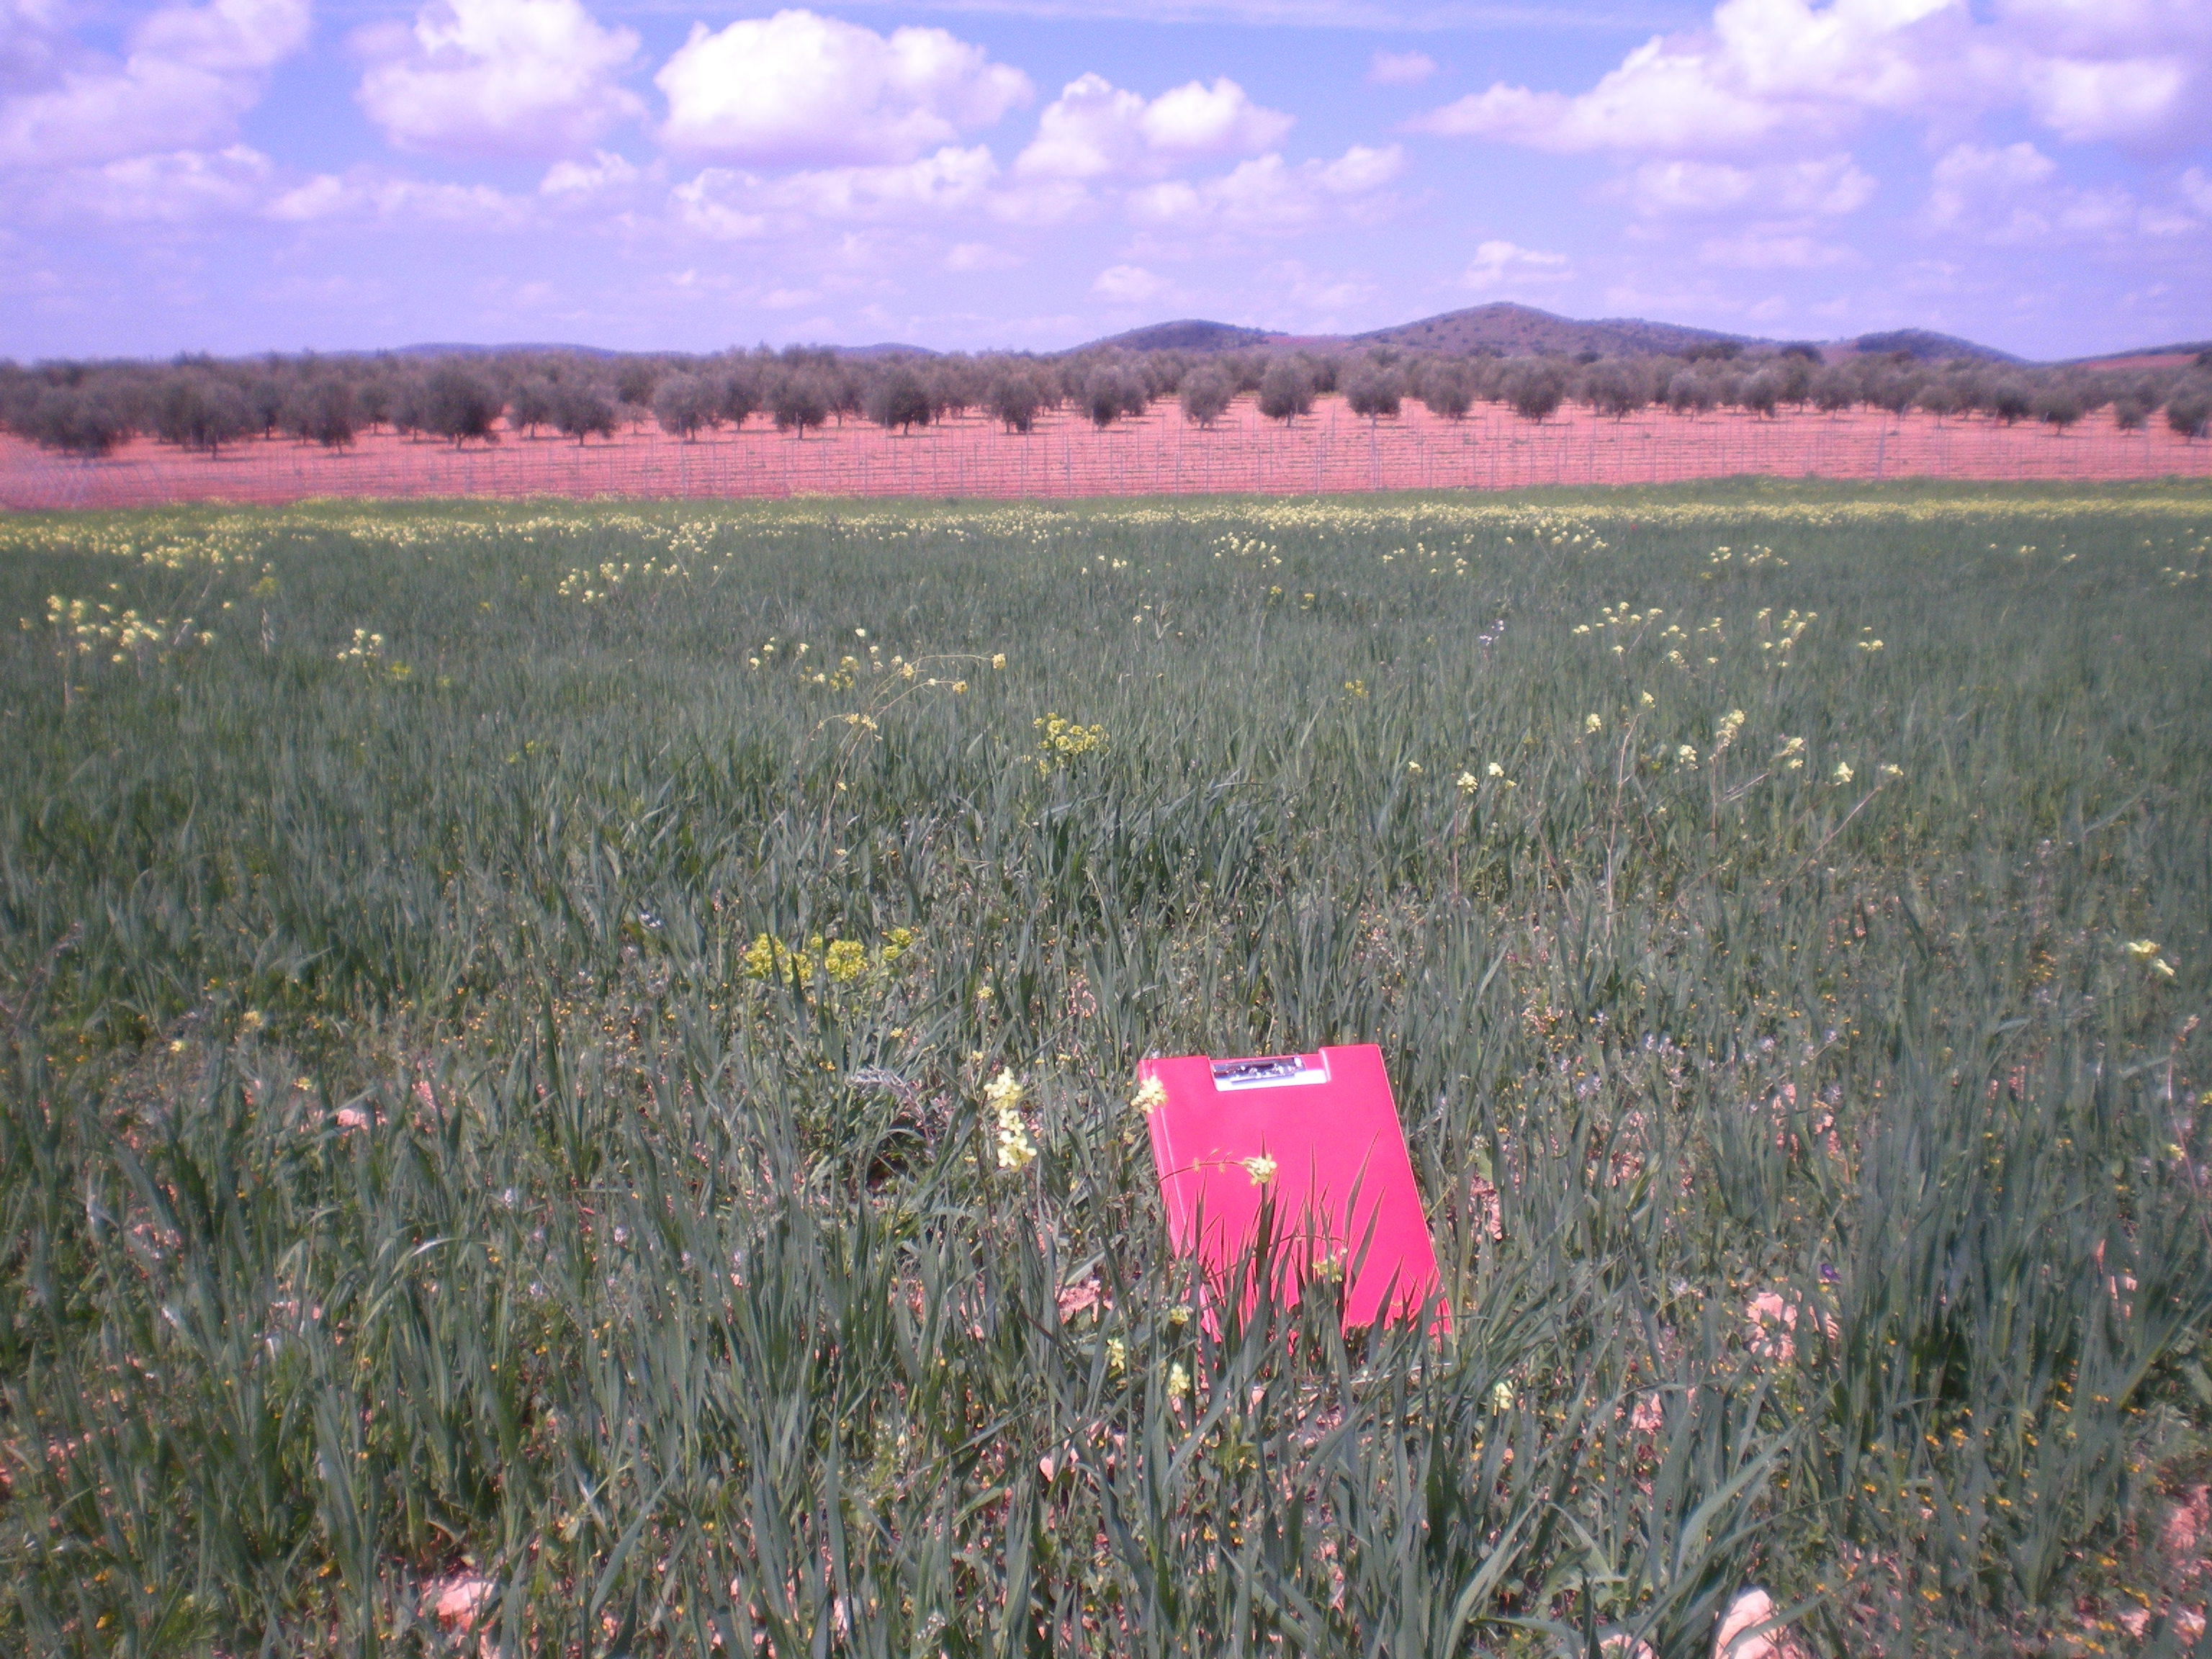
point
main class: Cropland
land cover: Oats
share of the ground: > 75 %
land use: Agriculture (excluding fallow land and kitchen gardens)
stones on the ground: 25 - 50 %
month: April
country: ES
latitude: 38.7033
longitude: -3.5227
